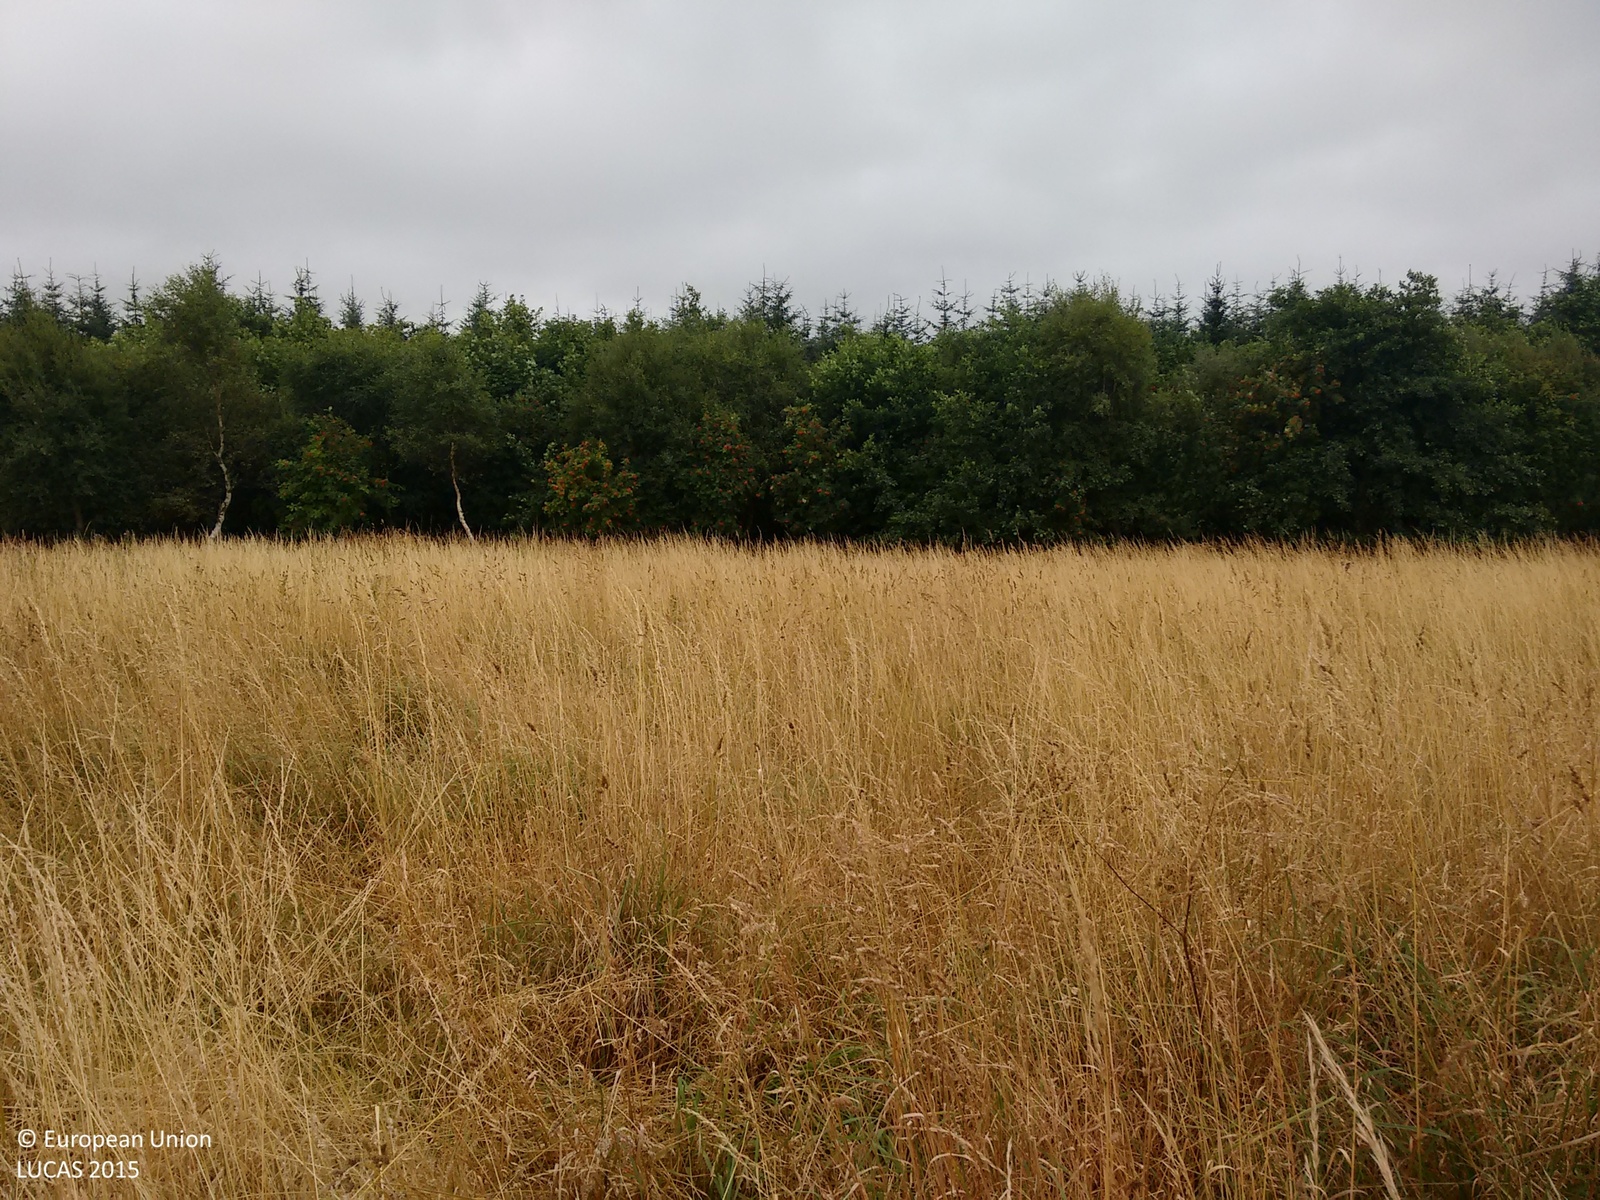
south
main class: Grassland
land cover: Grassland without tree/shrub cover
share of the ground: > 75 %
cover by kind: herbaceous plants 100 %
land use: Agriculture (excluding fallow land and kitchen gardens)
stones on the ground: 10 - 25 %
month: September
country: GB
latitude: 57.6867
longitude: -2.8896
